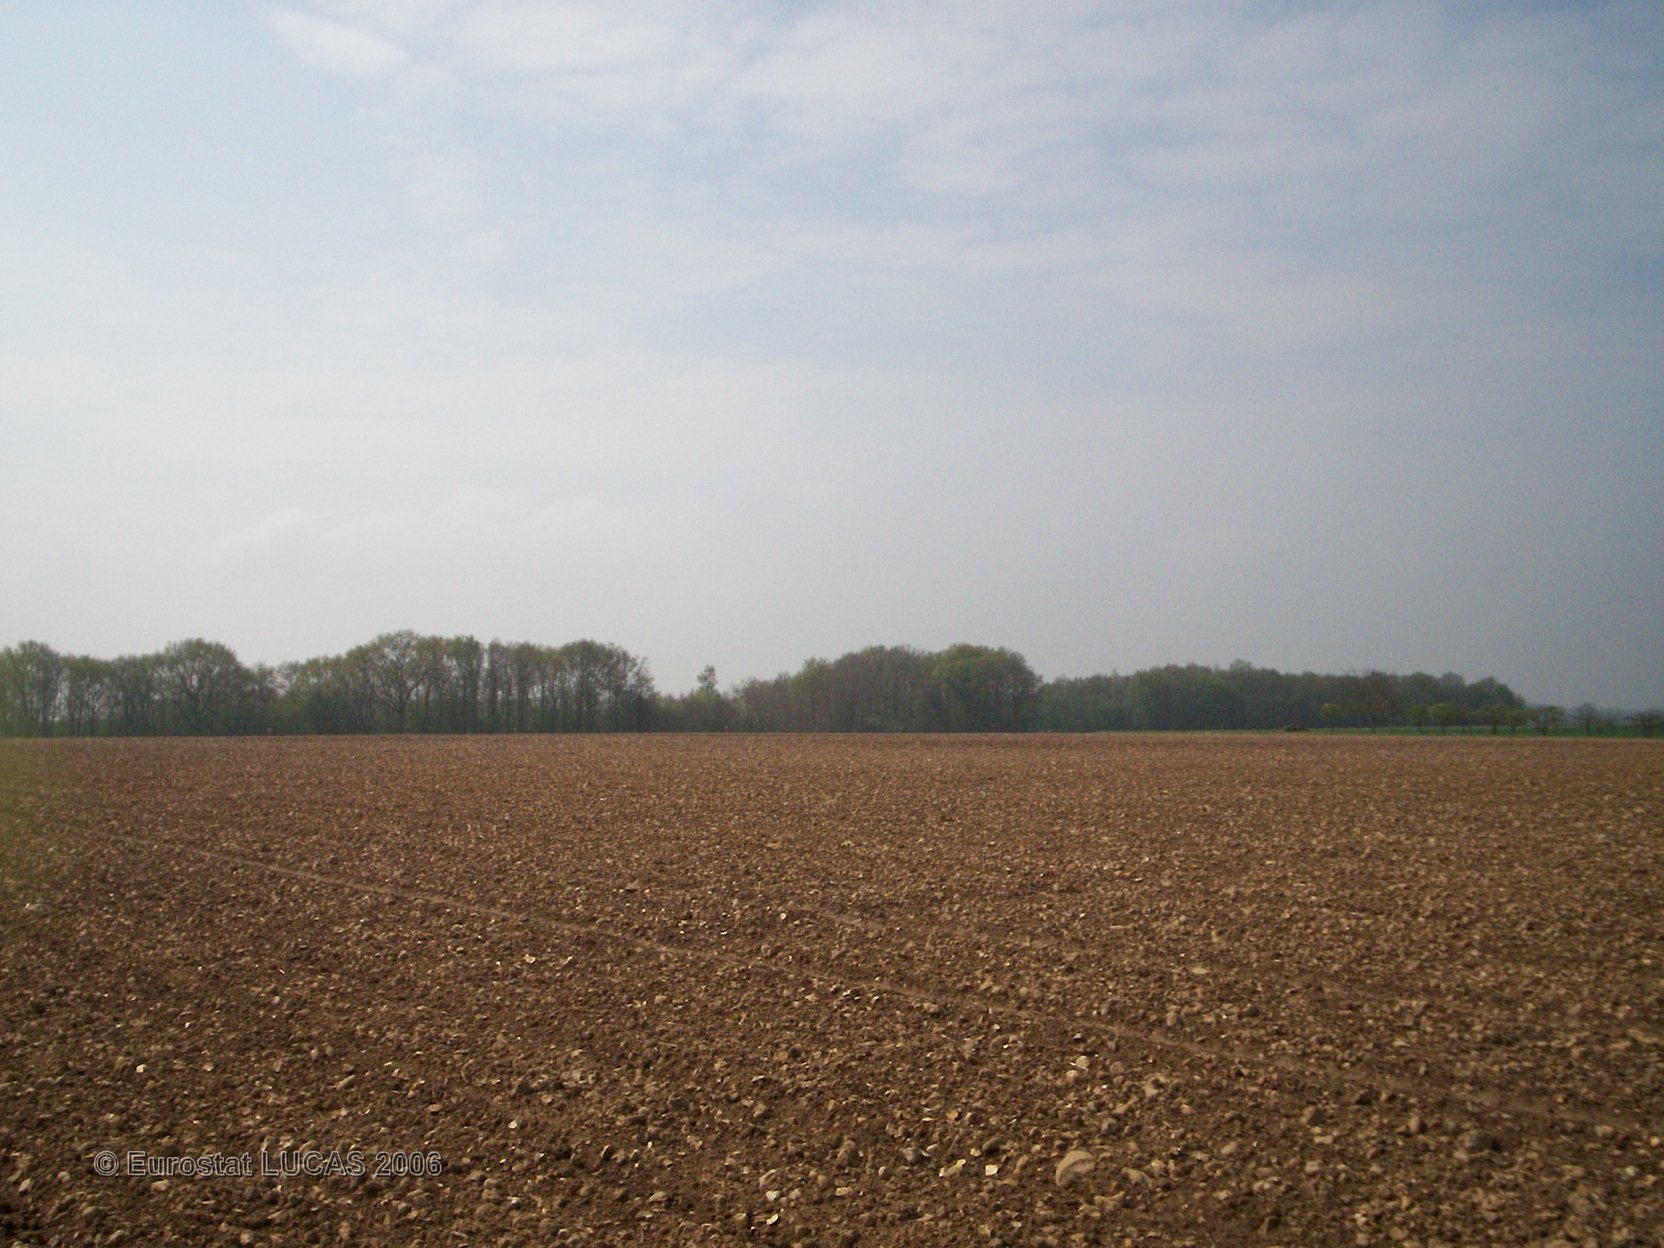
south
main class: Cropland
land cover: Sunflower
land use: Agriculture (excluding fallow land and kitchen gardens)
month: April
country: FR
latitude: 47.9572
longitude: 2.8816
